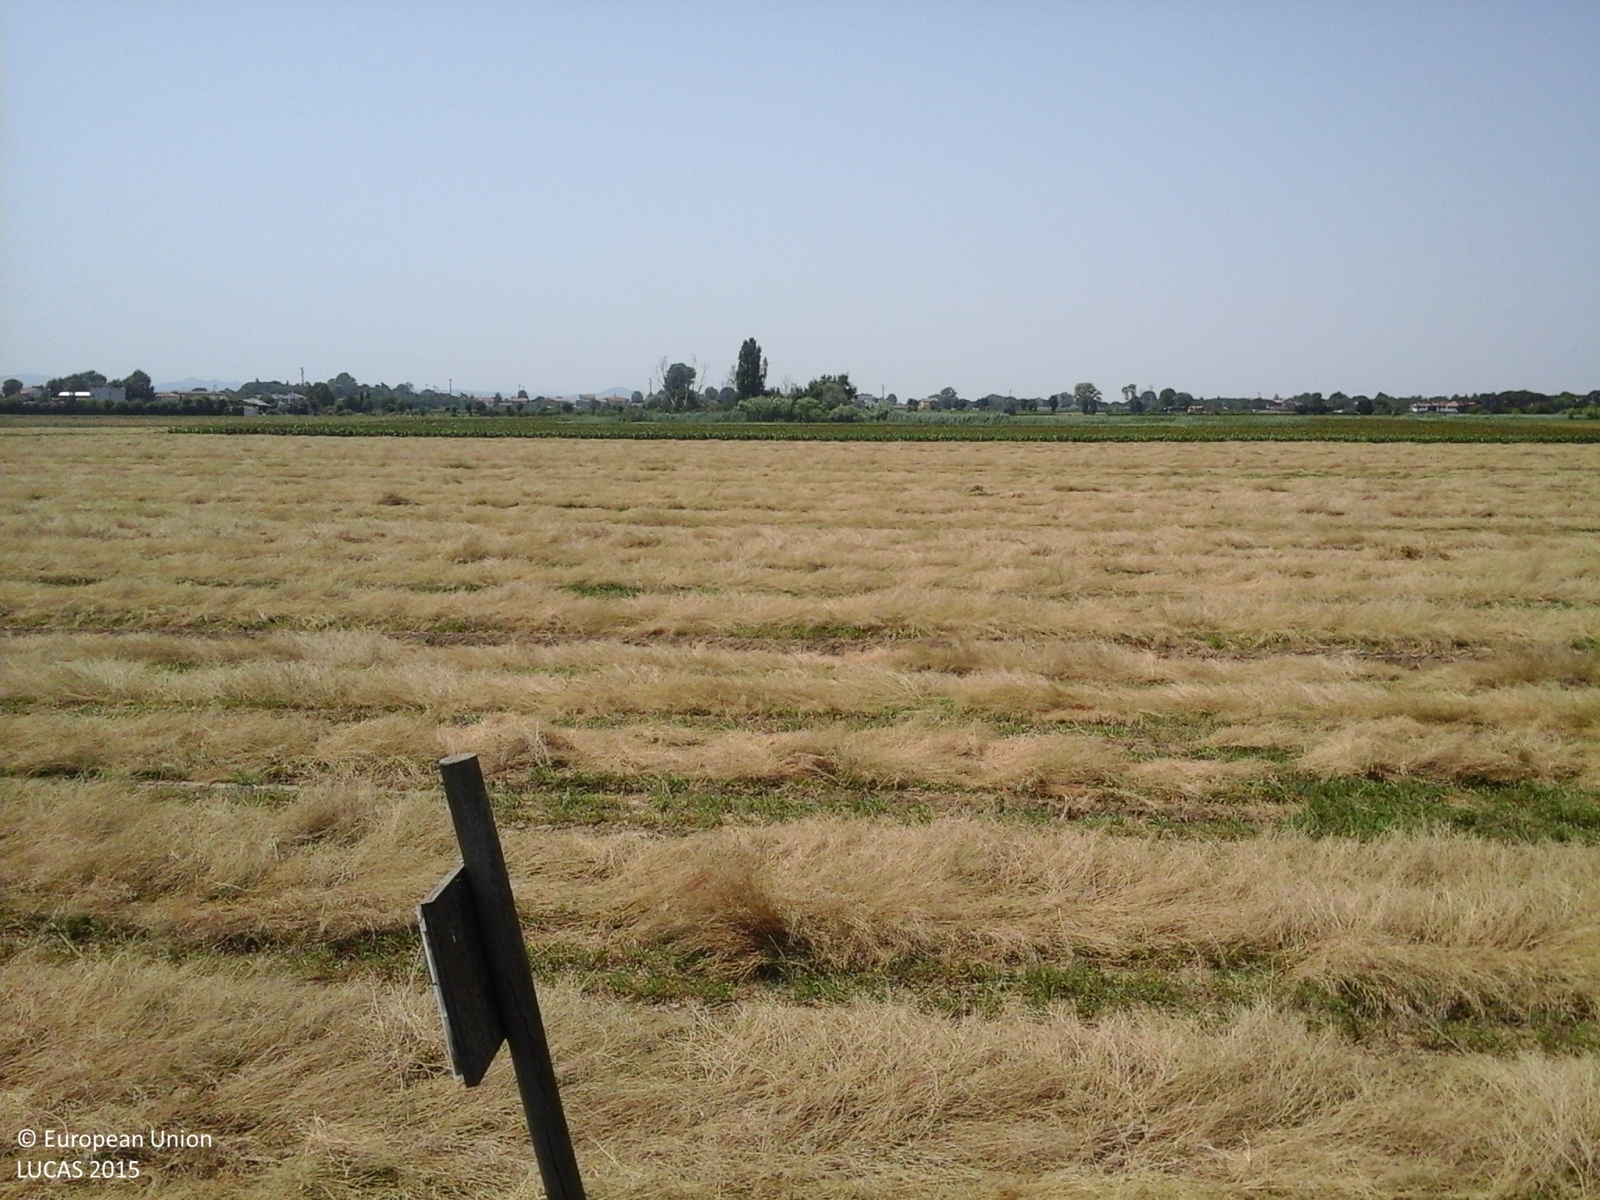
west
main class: Grassland
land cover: Grassland without tree/shrub cover
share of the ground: > 75 %
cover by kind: herbaceous plants 100 %
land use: Semi-natural and natural areas not in use
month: July
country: IT
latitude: 44.1602
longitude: 12.4080
